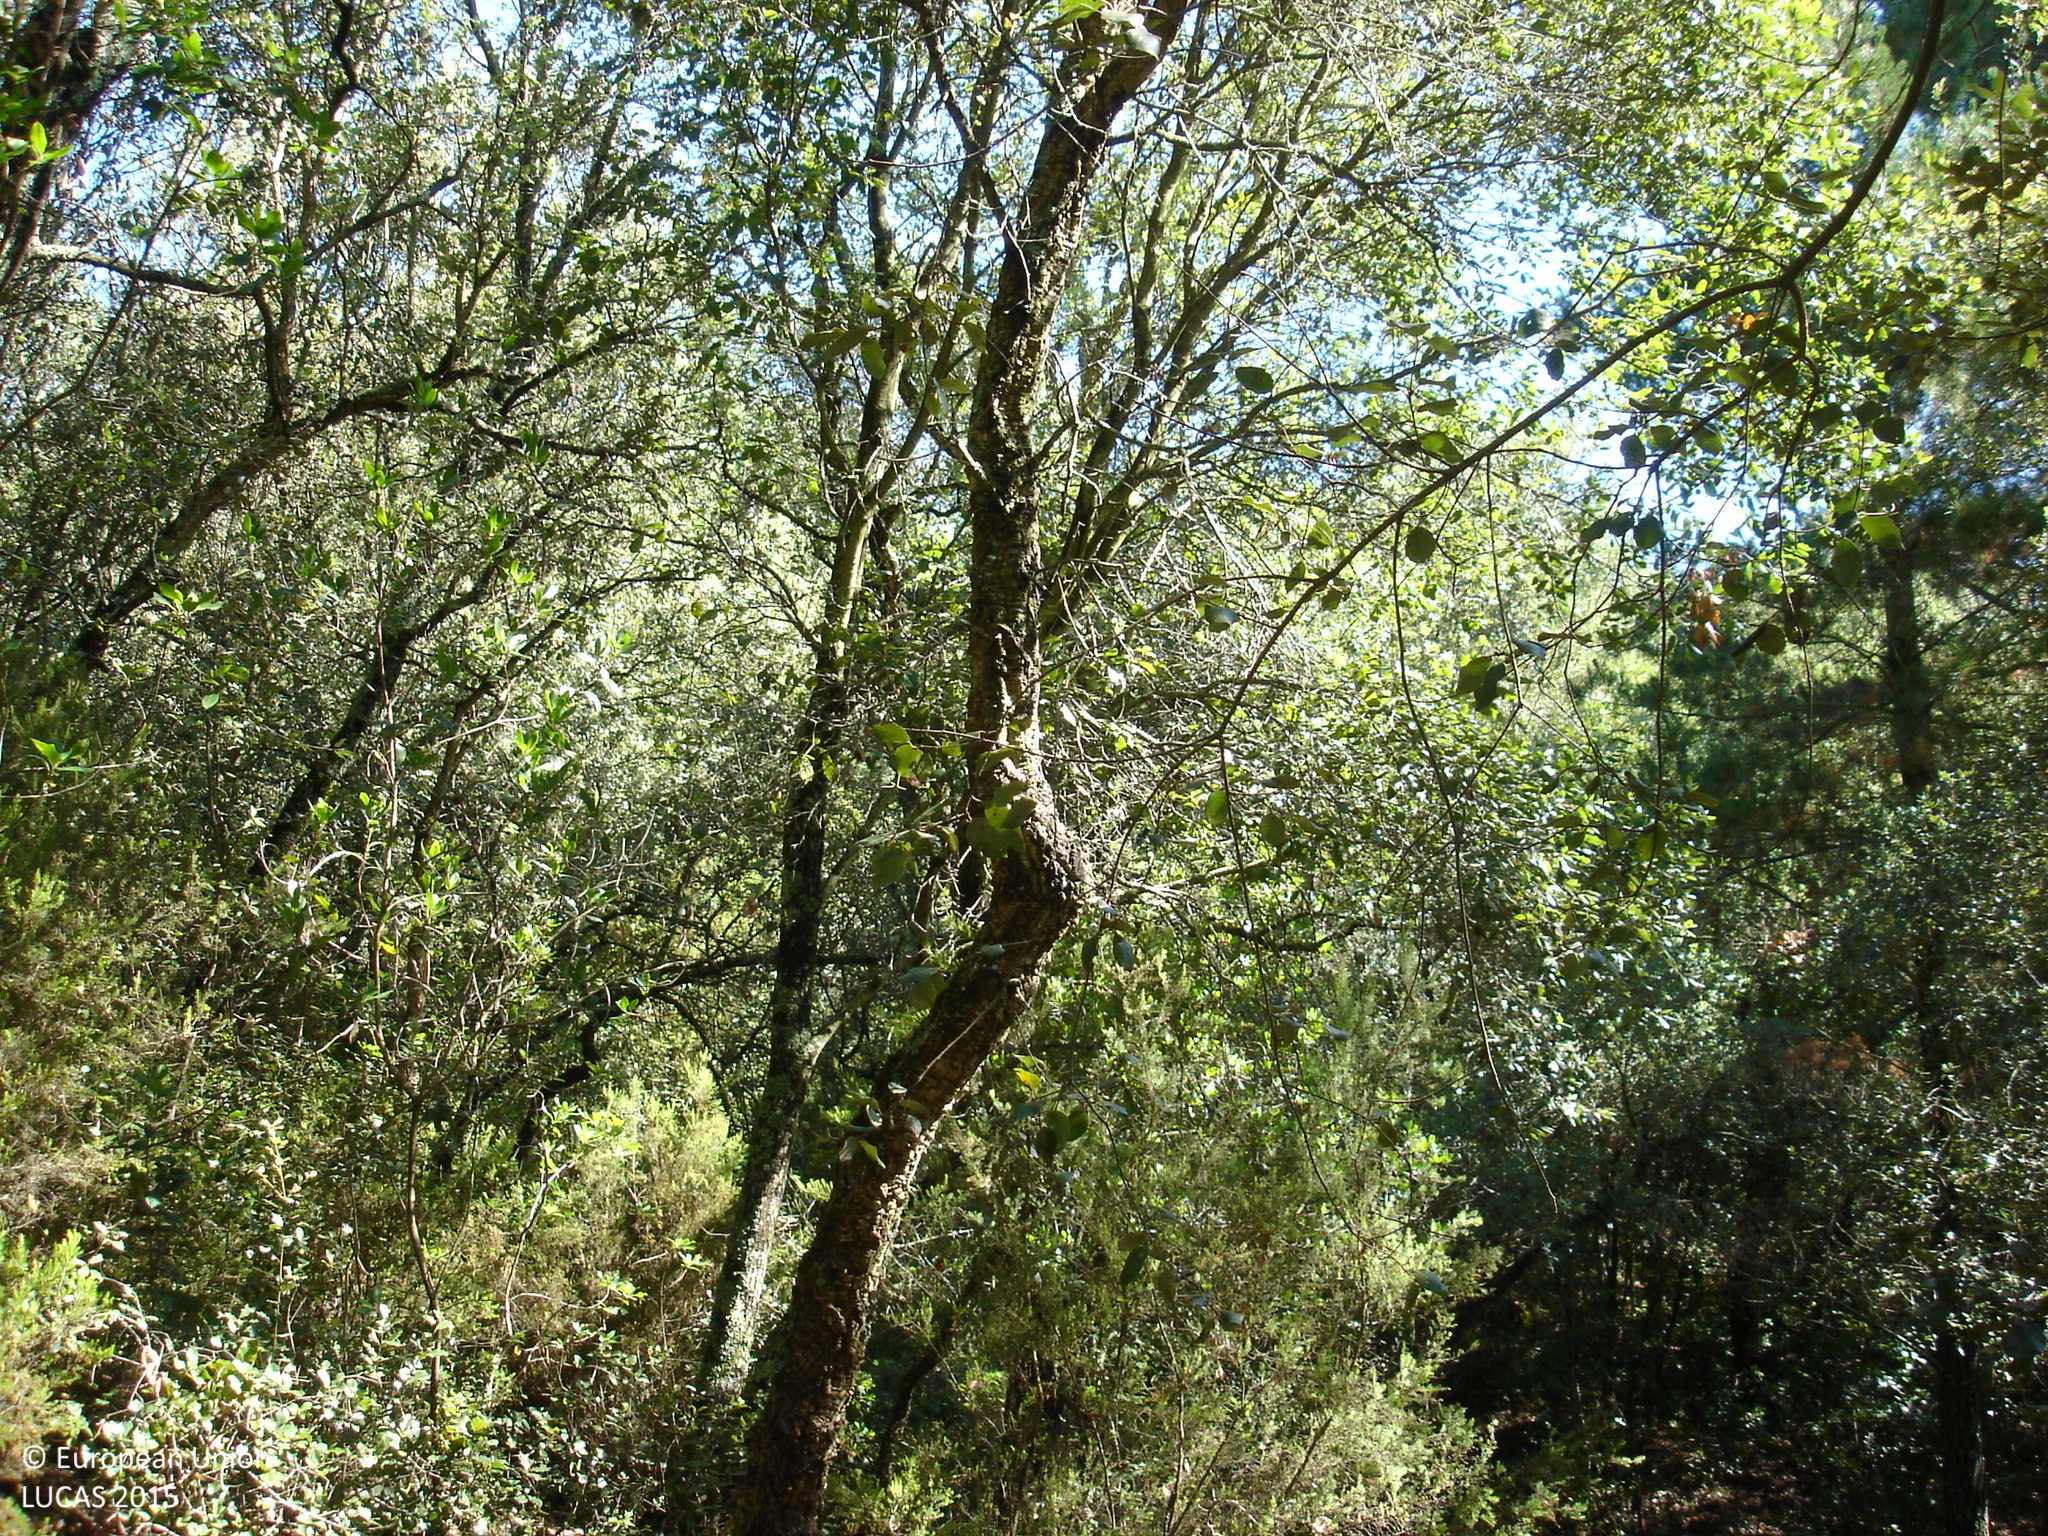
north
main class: Woodland
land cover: Broadleaved woodland
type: thermophilous deciduous forest
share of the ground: > 75 %
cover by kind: broadleaved forest trees 90 %, herbaceous plants 10 %
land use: Forestry
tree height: > 5 m
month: June
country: ES
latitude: 41.7824
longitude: 2.5686
